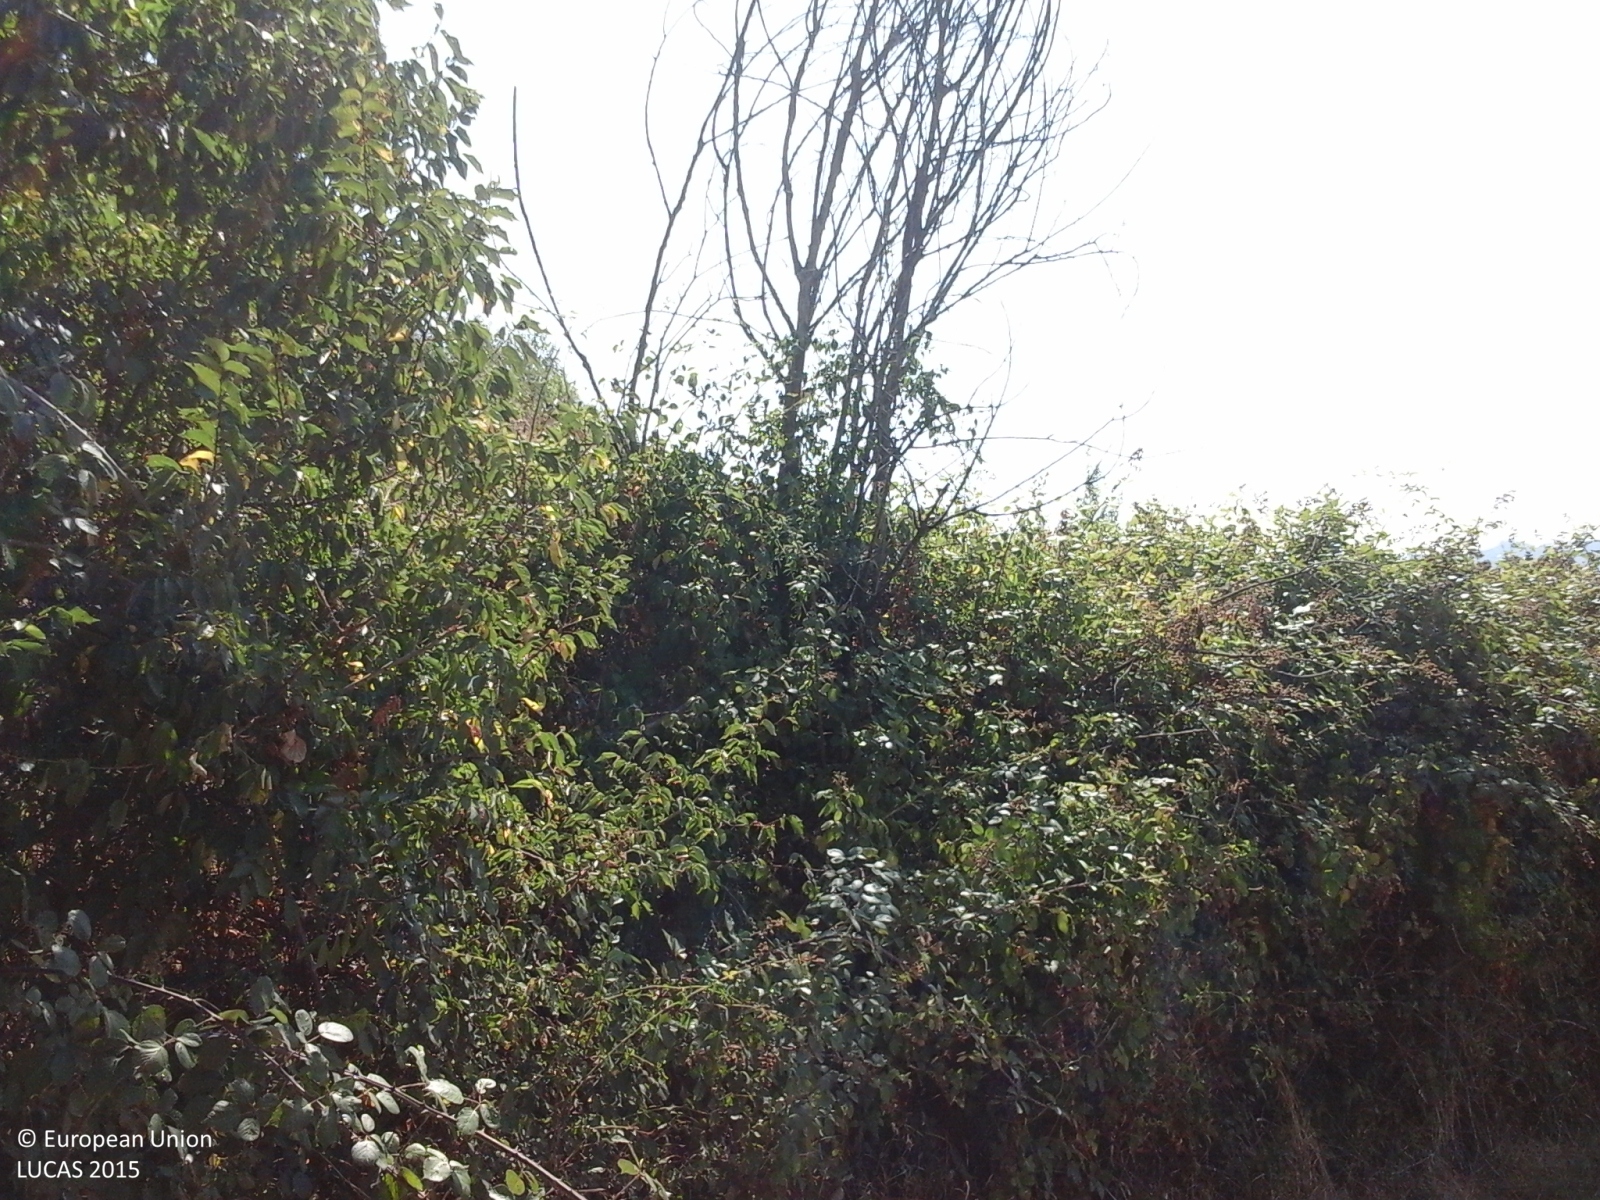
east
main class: Woodland
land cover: Broadleaved woodland
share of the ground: > 75 %
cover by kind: broadleaved forest trees 100 %
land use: Residential
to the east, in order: Broadleaved woodland; Artificial constructions in urban areas; Broadleaved woodland; Electric lines; Broadleaved woodland; Grassland without tree/shrub cover; Abandoned hedges; Grass margins; Paved roads, cycling and walking lanes; Grass margins; Grassland without tree/shrub cover
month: July
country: IT
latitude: 43.4646
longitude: 10.6286
